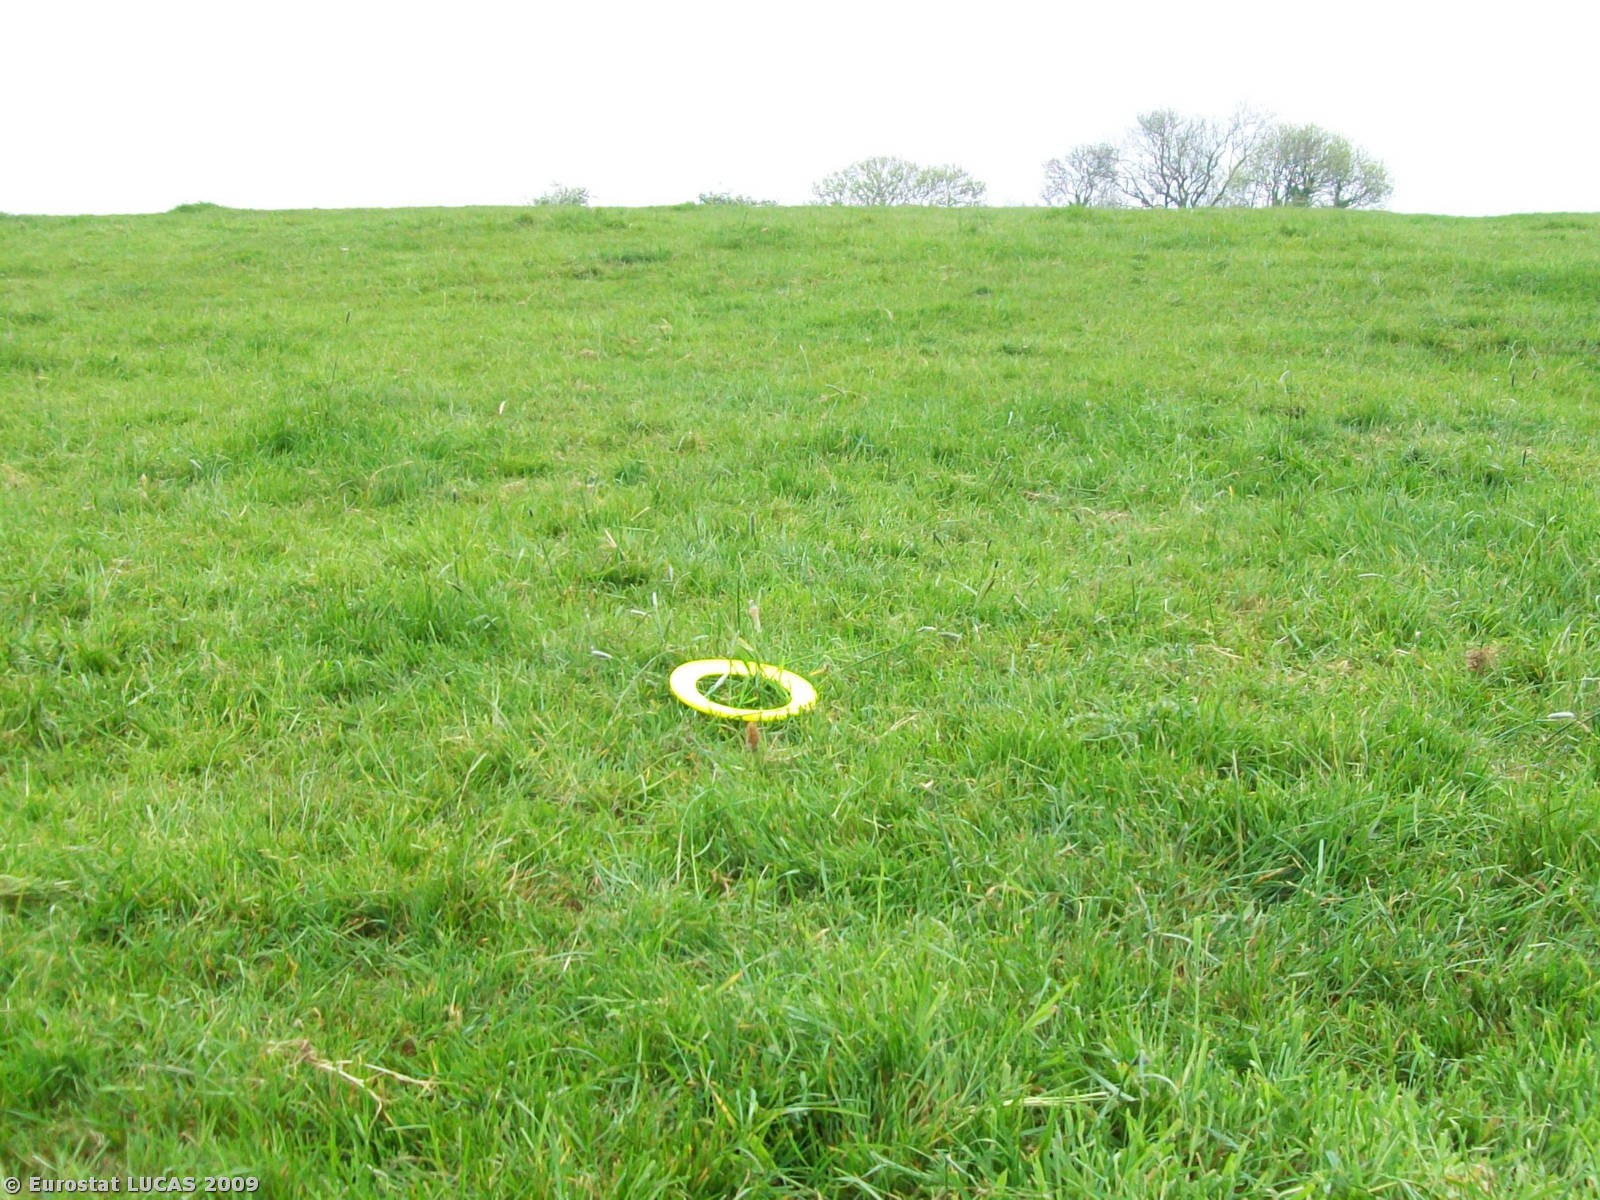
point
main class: Grassland
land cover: Grassland without tree/shrub cover
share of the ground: > 75 %
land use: Agriculture (excluding fallow land and kitchen gardens)
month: May
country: GB
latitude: 52.7491
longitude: -1.0521
